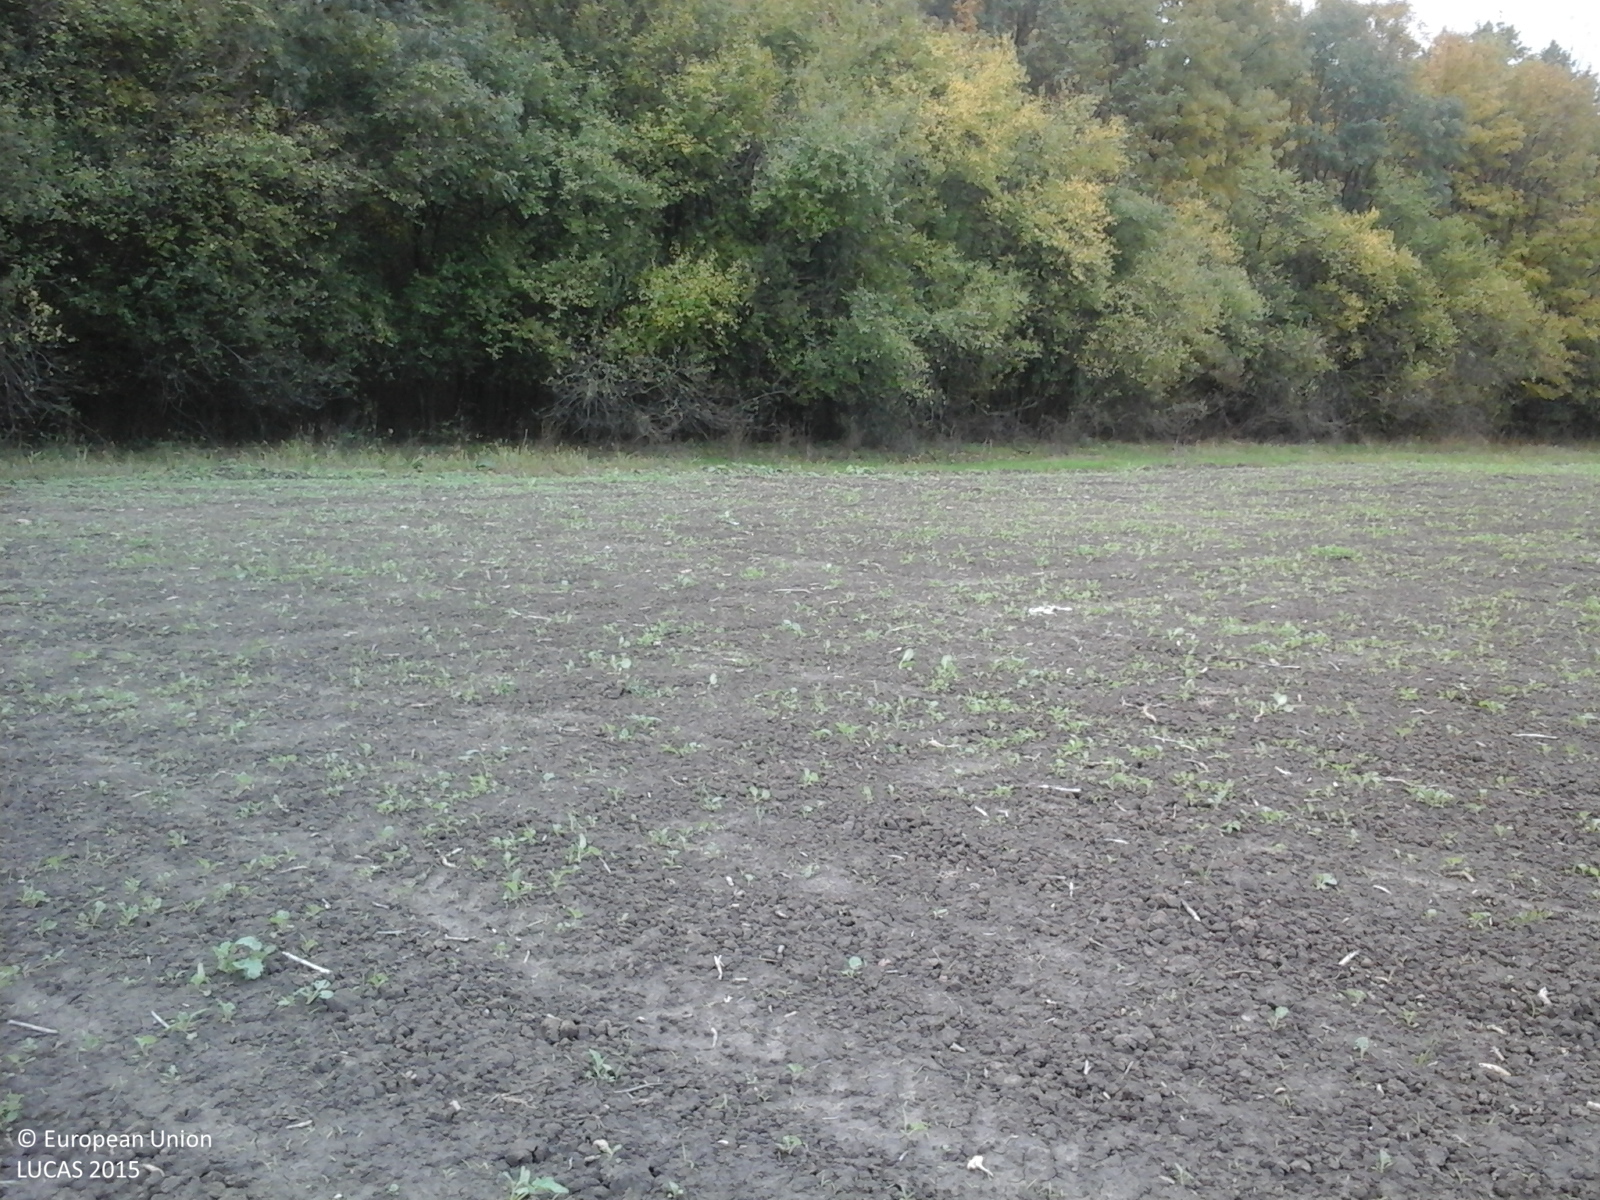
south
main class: Cropland
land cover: Rape and turnip rape
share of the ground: < 10 %
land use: Agriculture (excluding fallow land and kitchen gardens)
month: October
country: RO
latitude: 44.8459
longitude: 26.2181
